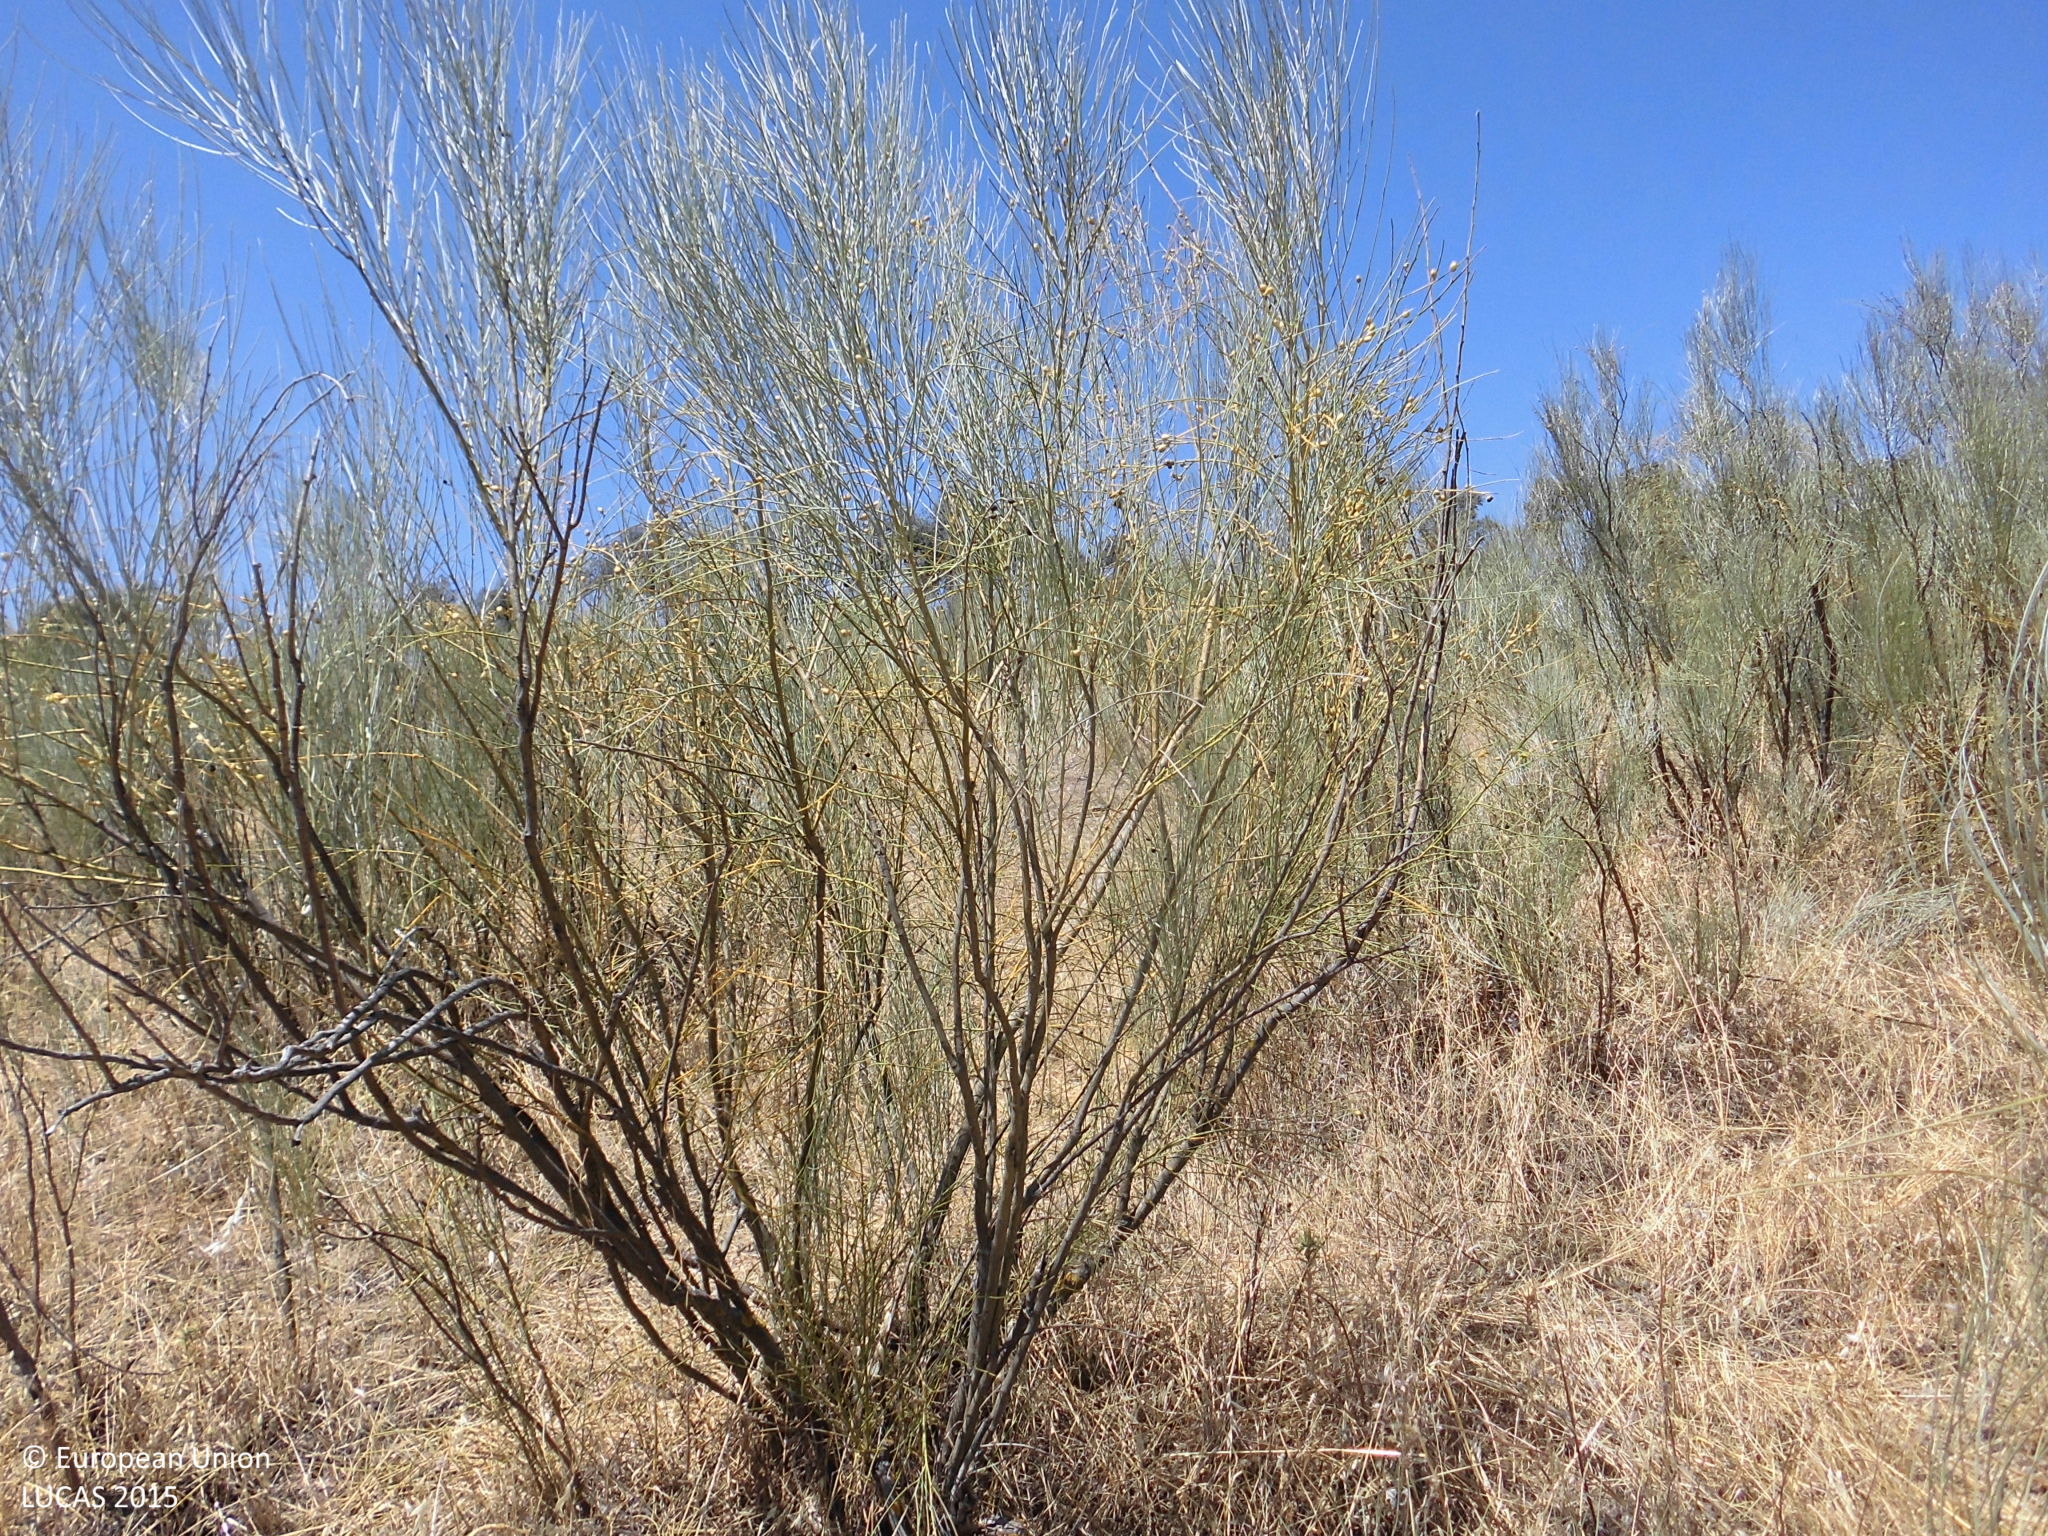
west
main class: Shrubland
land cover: Shrubland without tree cover
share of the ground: 25 - 50 %
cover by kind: herbaceous plants 65 %, shrubs 35 %
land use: Agriculture (excluding fallow land and kitchen gardens)
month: July
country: ES
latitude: 39.9967
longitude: -6.2016
